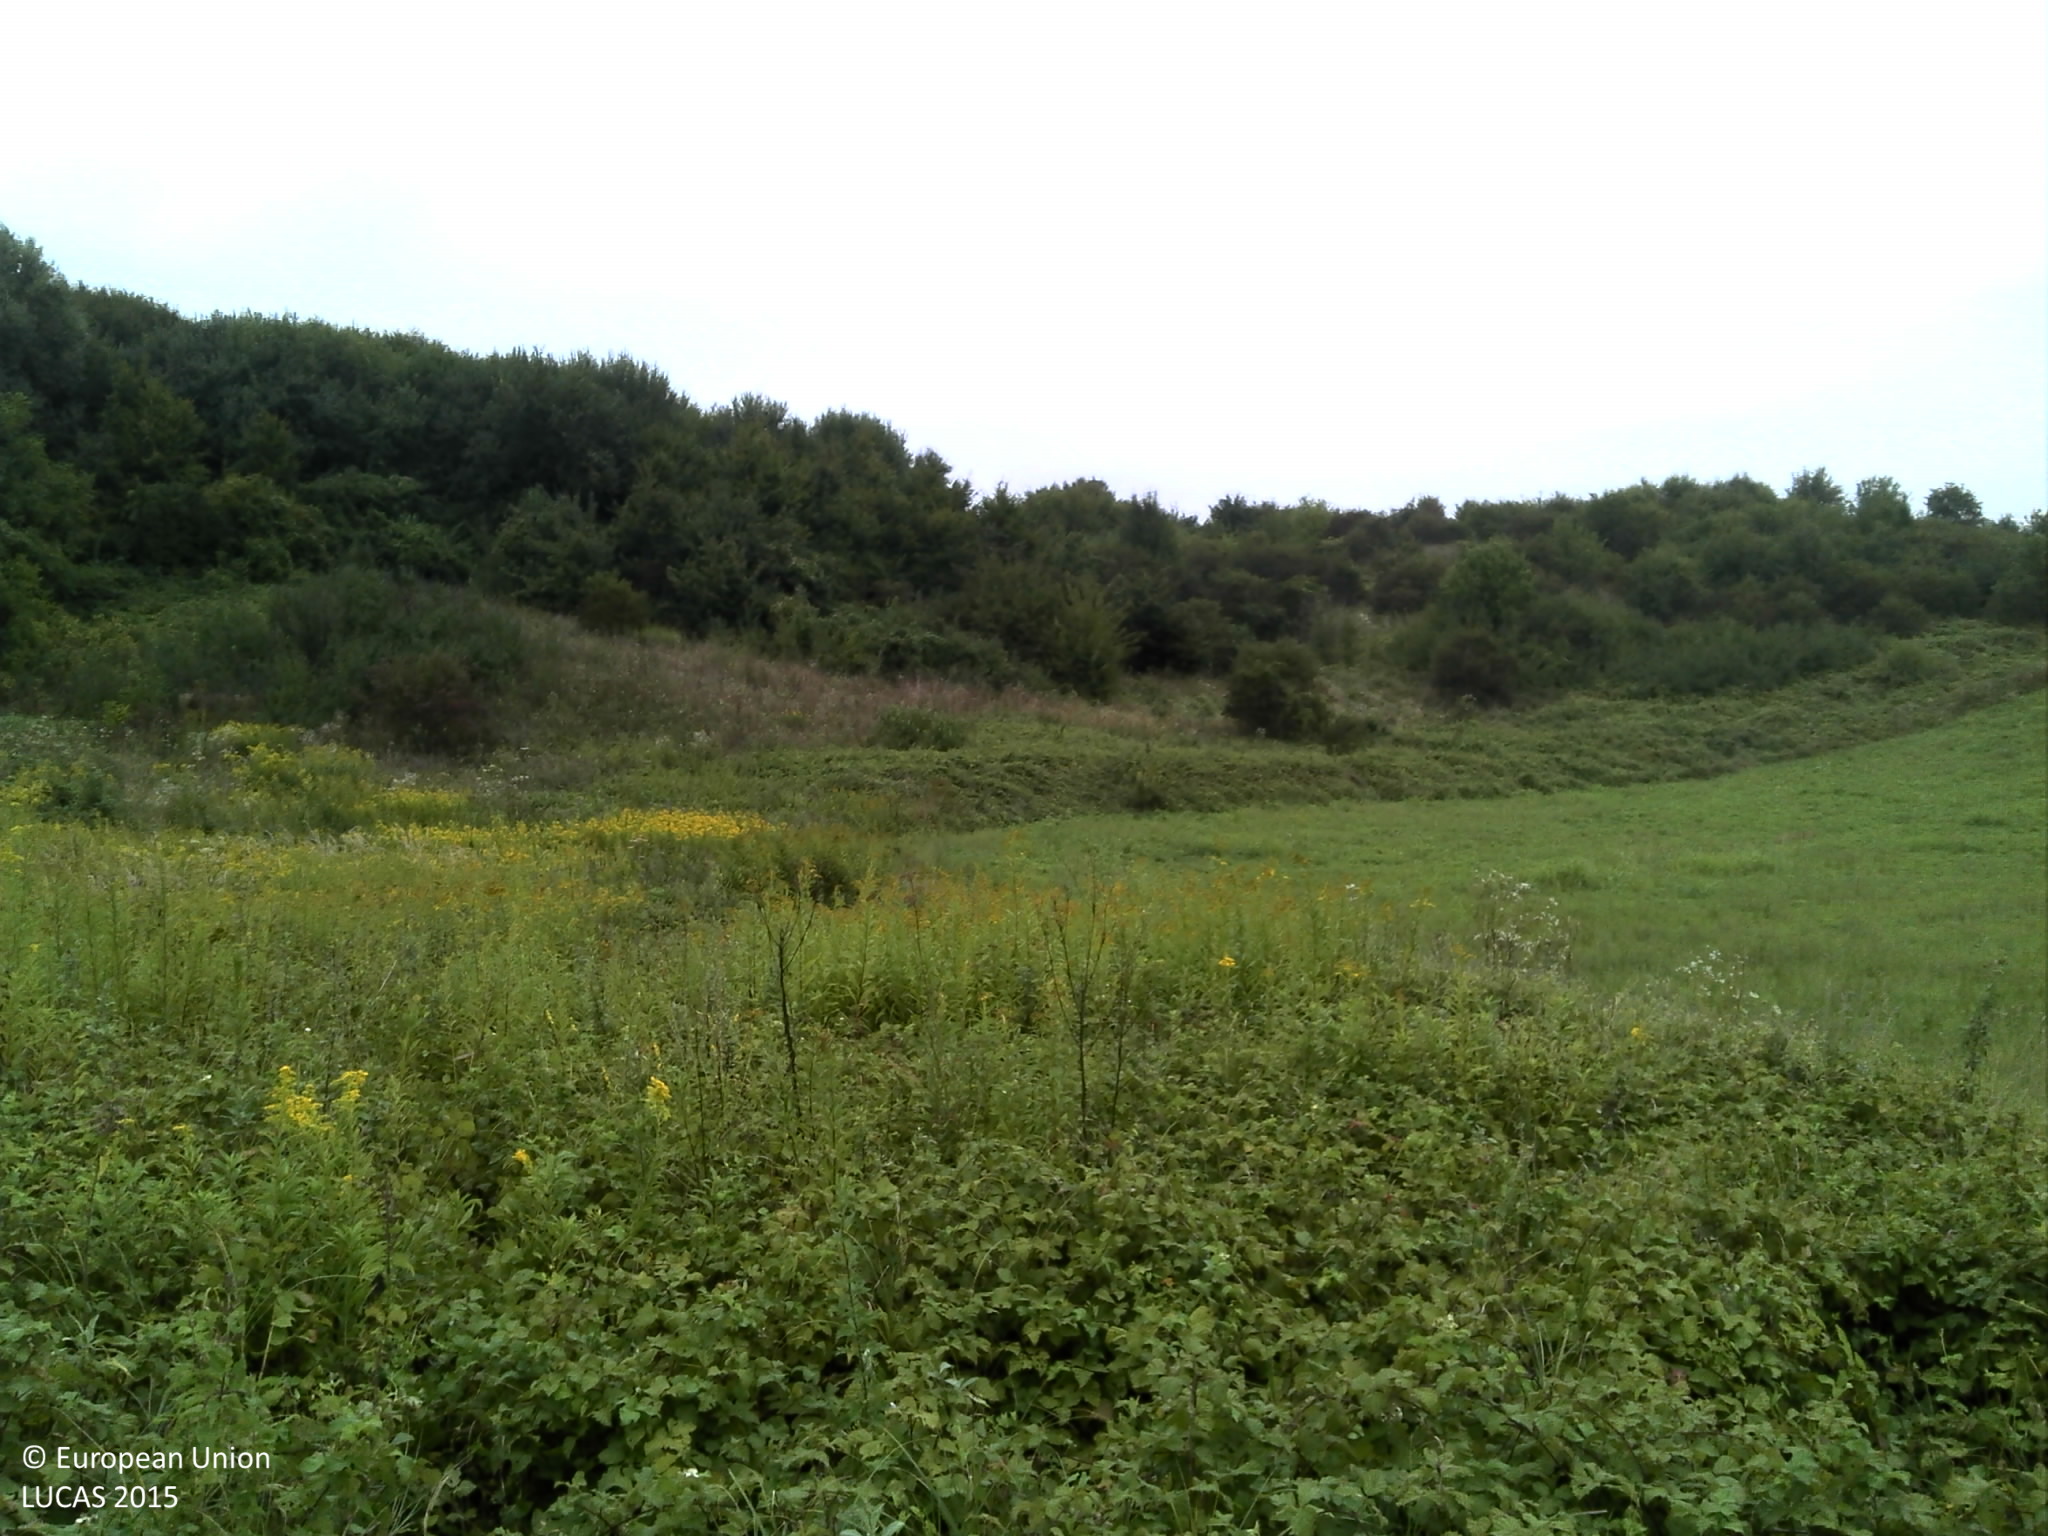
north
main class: Grassland
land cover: Spontaneously vegetated surfaces
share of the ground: > 75 %
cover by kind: herbaceous plants 100 %
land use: Semi-natural and natural areas not in use
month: August
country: HR
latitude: 45.2978
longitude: 15.6706
